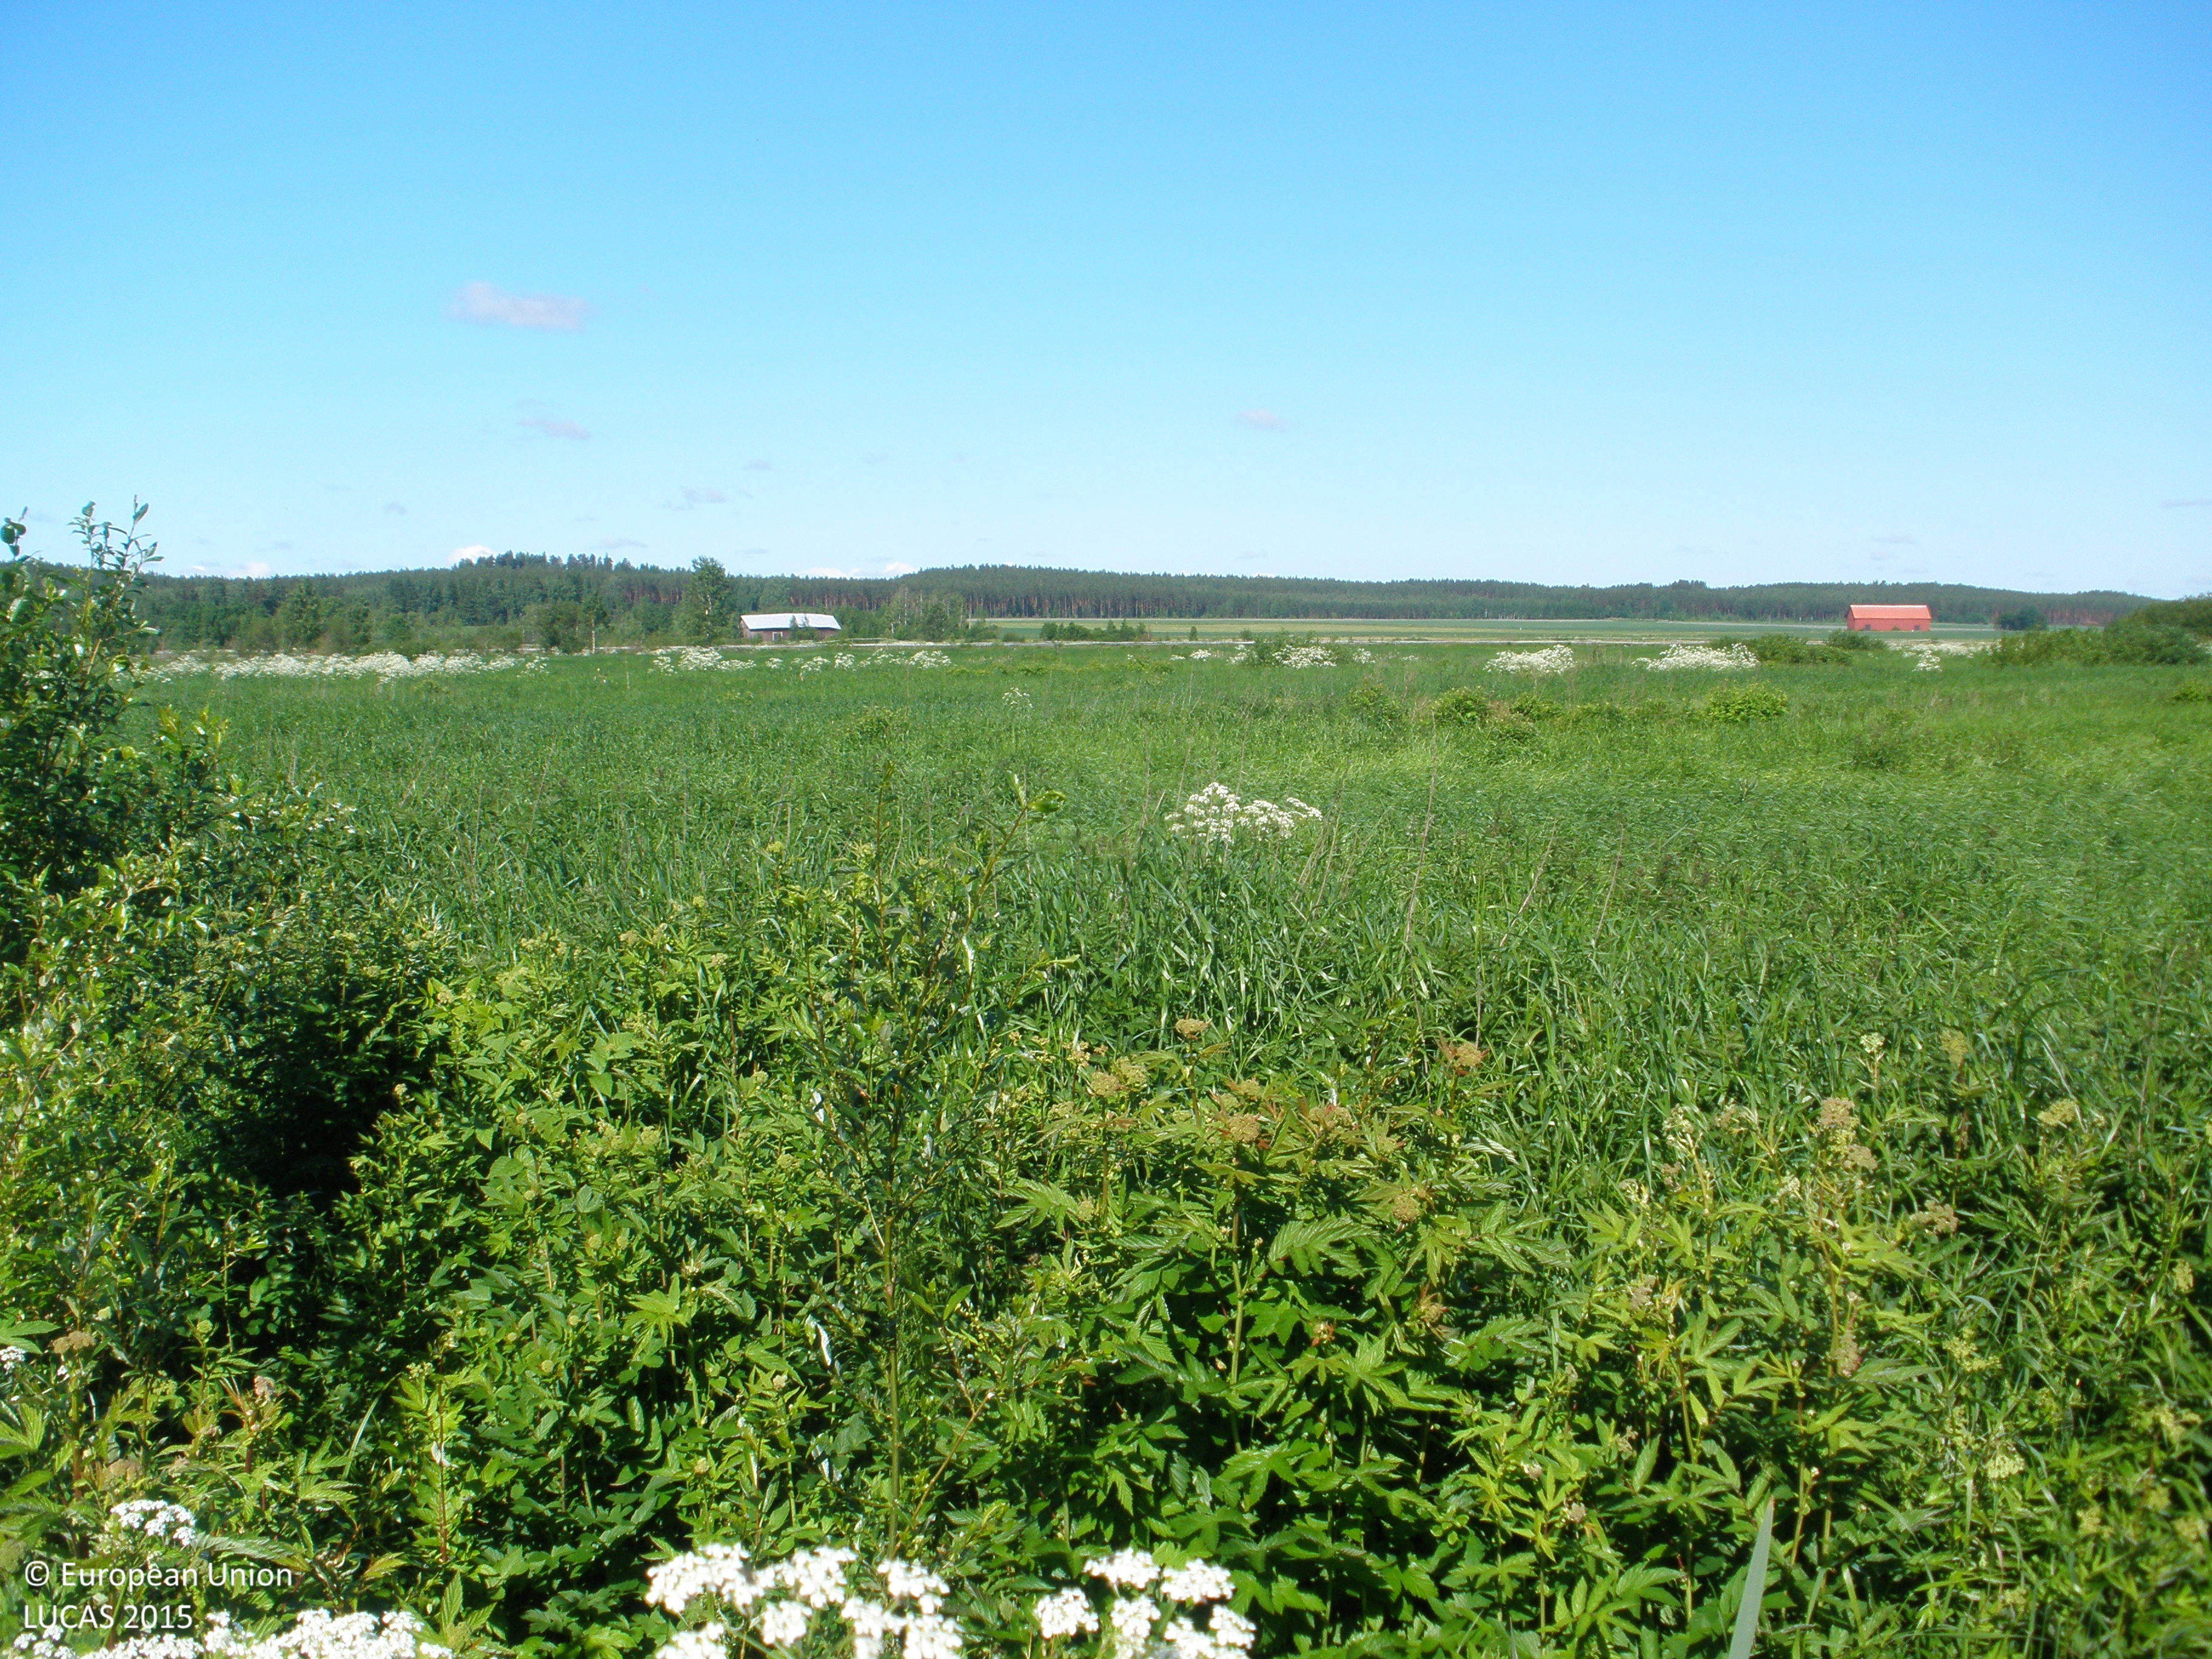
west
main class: Grassland
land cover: Spontaneously vegetated surfaces
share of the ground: > 75 %
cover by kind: herbaceous plants 100 %
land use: Fallow land
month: June
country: FI
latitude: 61.0958
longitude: 24.3235
